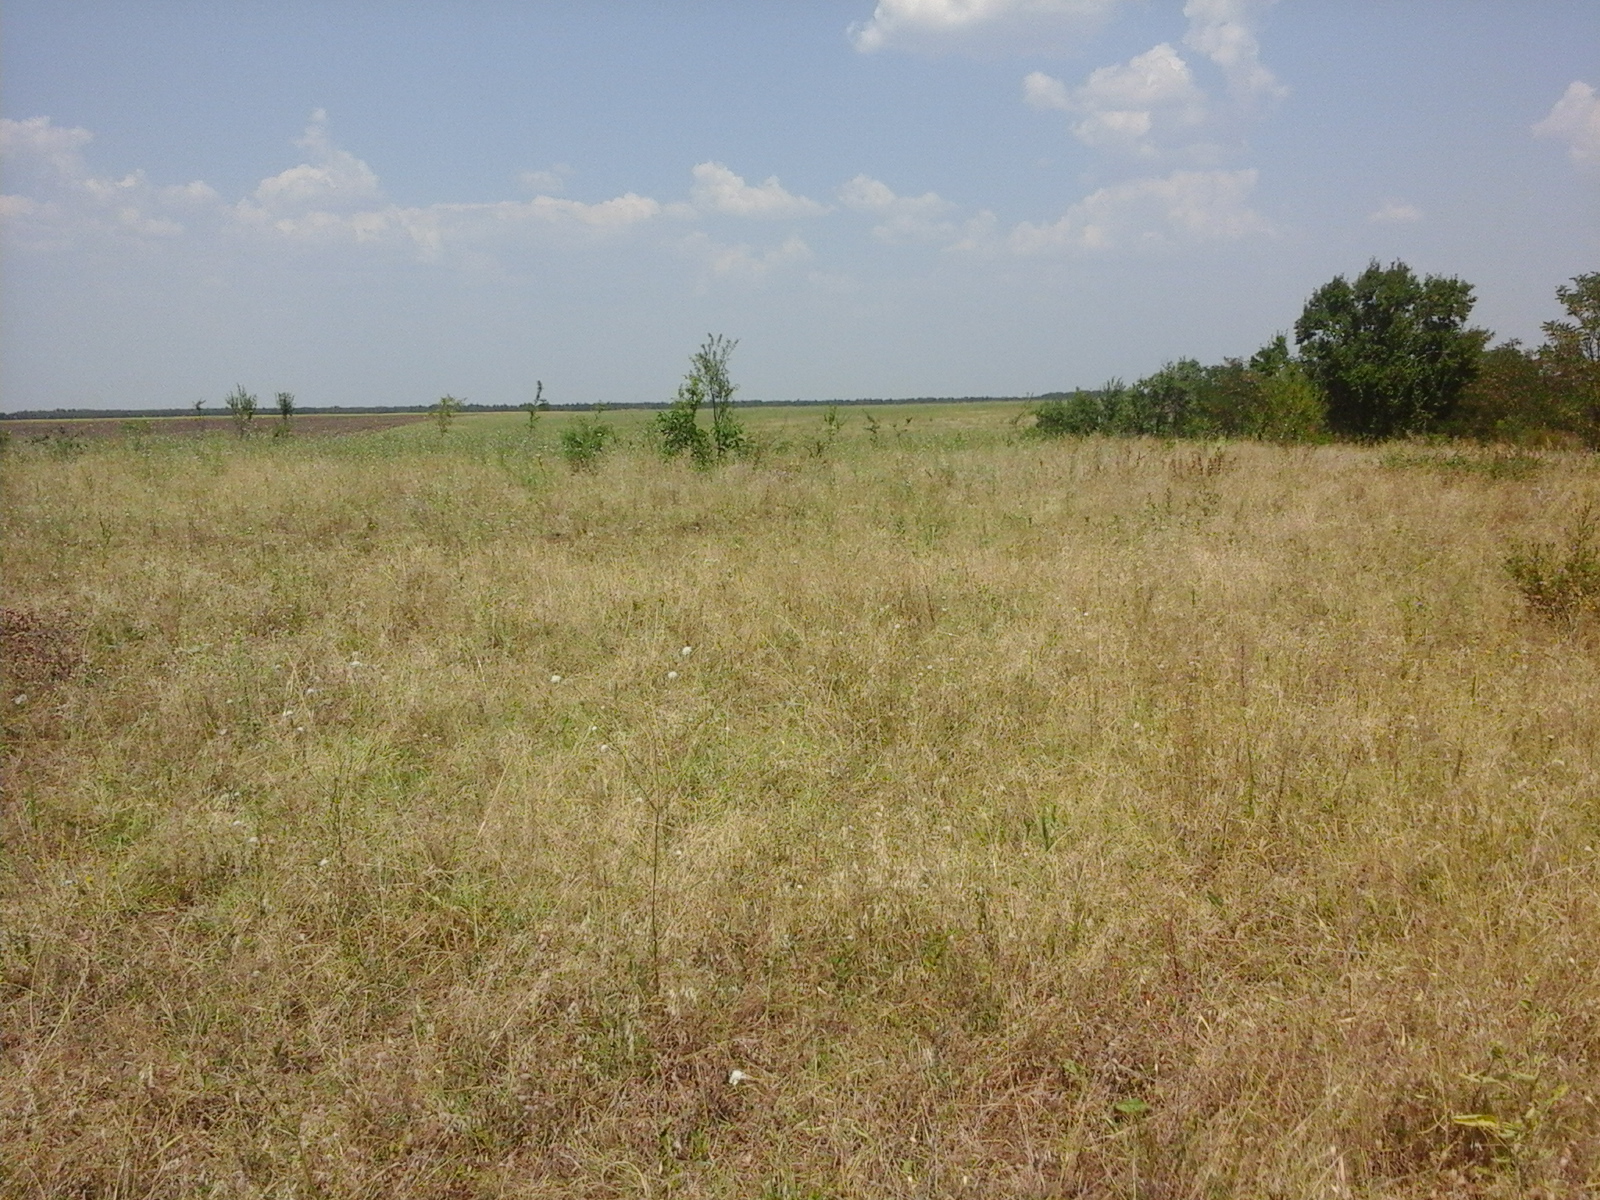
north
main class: Grassland
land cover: Grassland without tree/shrub cover
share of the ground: > 75 %
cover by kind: herbaceous plants 100 %
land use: Agriculture (excluding fallow land and kitchen gardens)
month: August
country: RO
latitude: 44.1975
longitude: 23.4763
